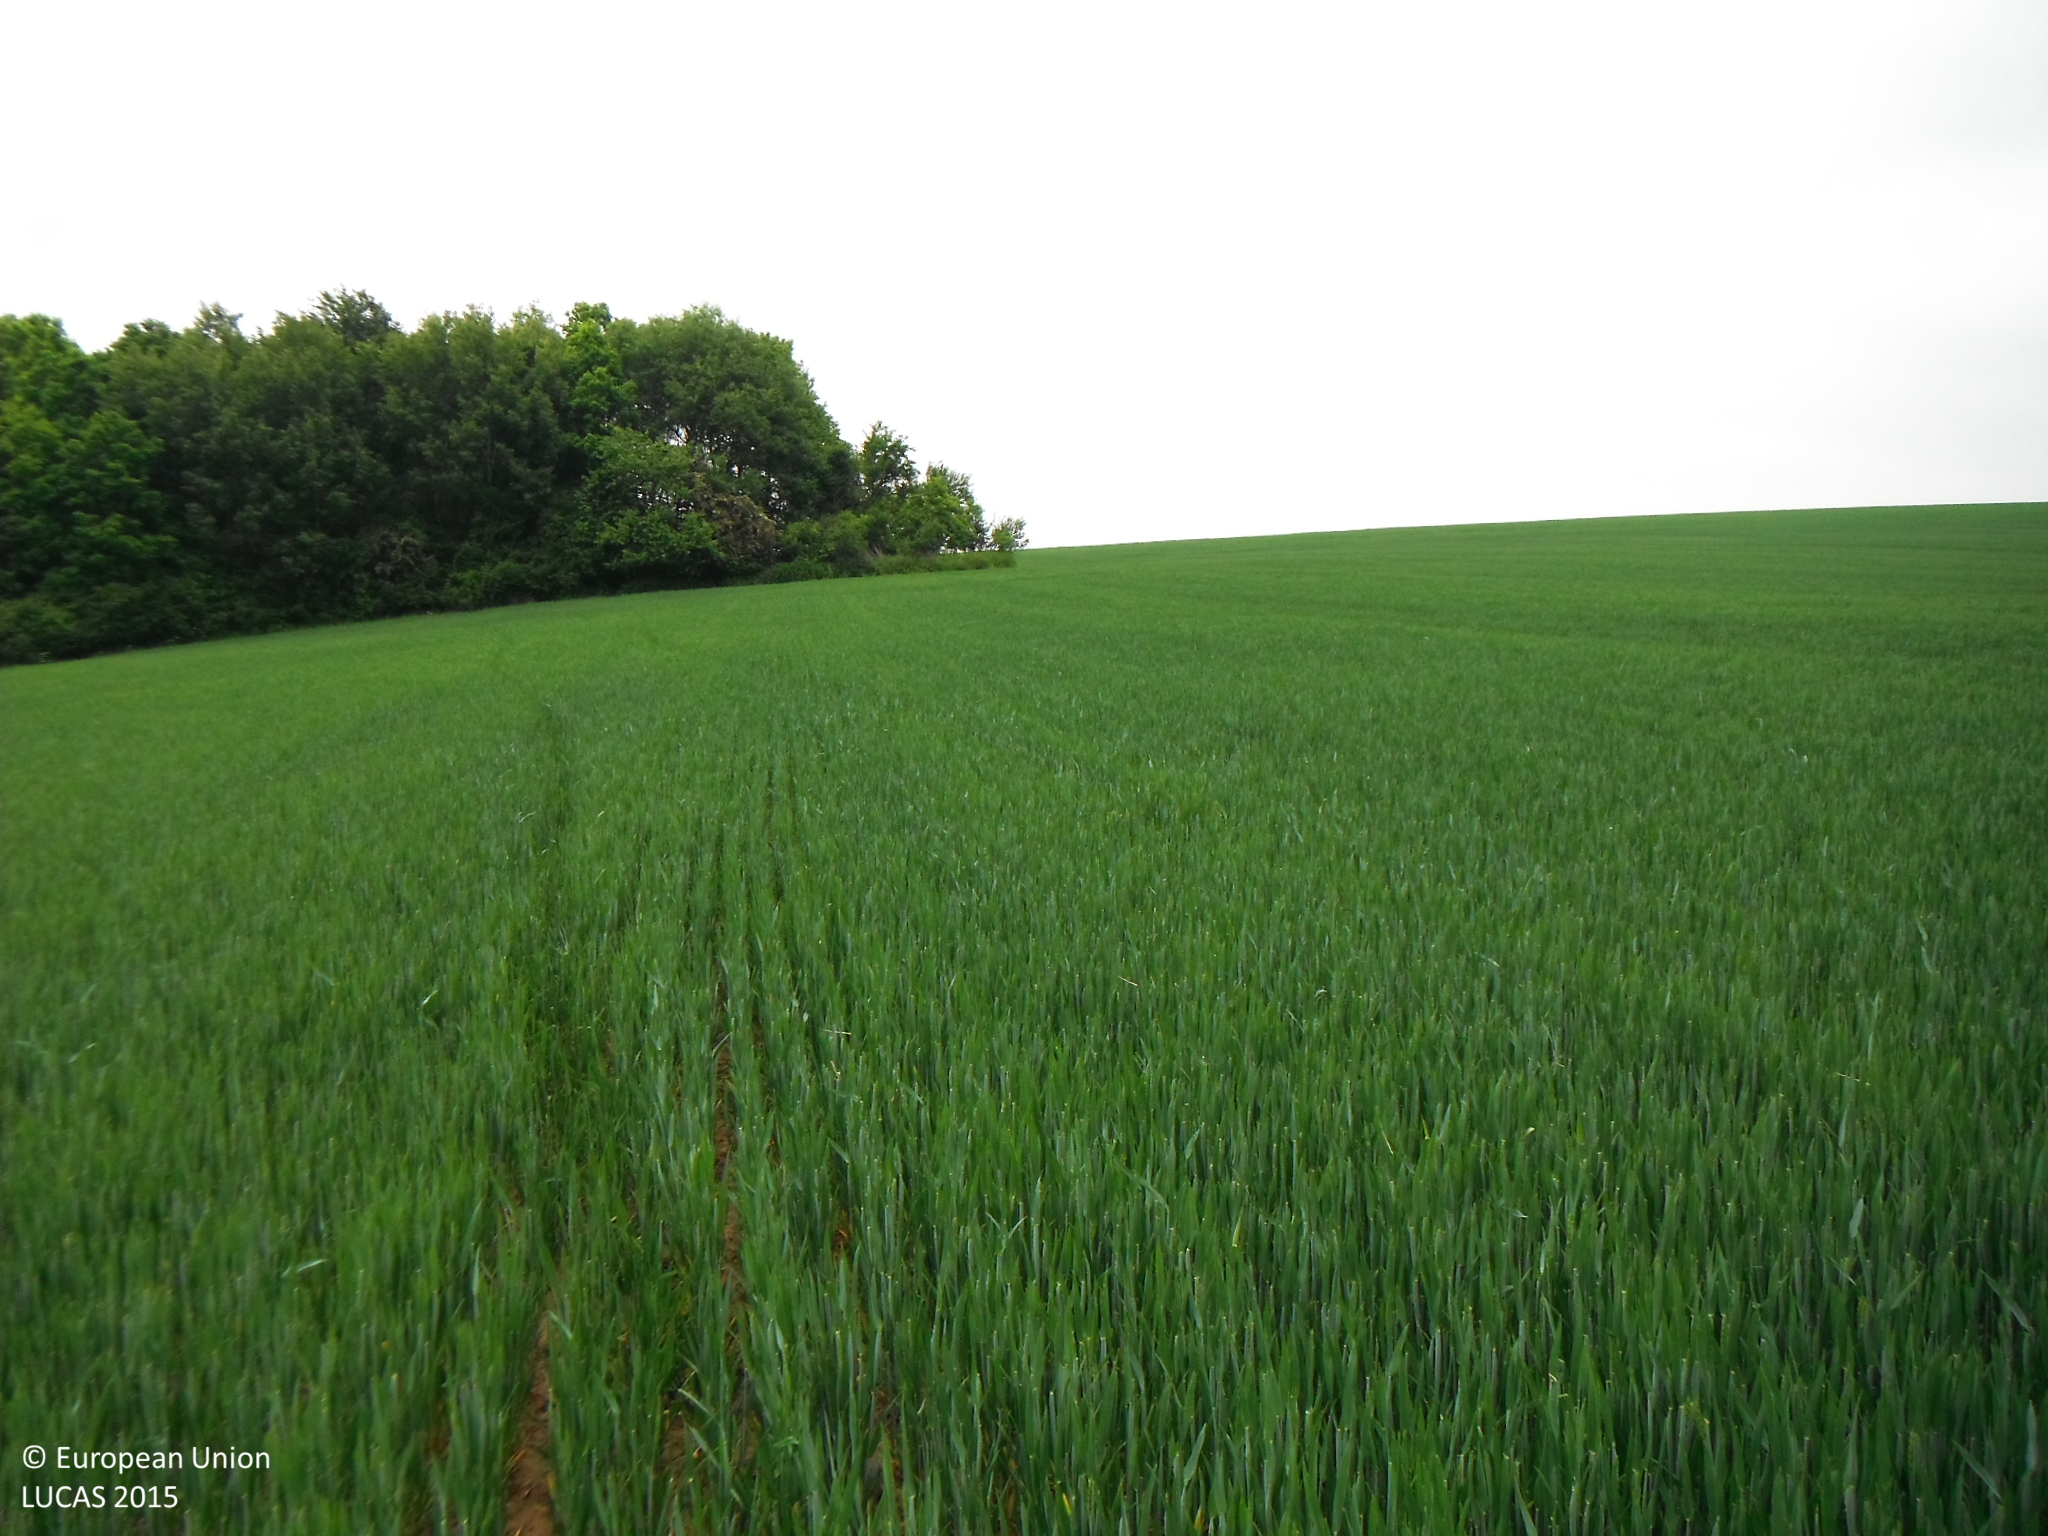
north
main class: Cropland
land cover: Common wheat
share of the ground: > 75 %
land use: Agriculture (excluding fallow land and kitchen gardens)
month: May
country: SK
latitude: 49.0047
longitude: 21.1024
